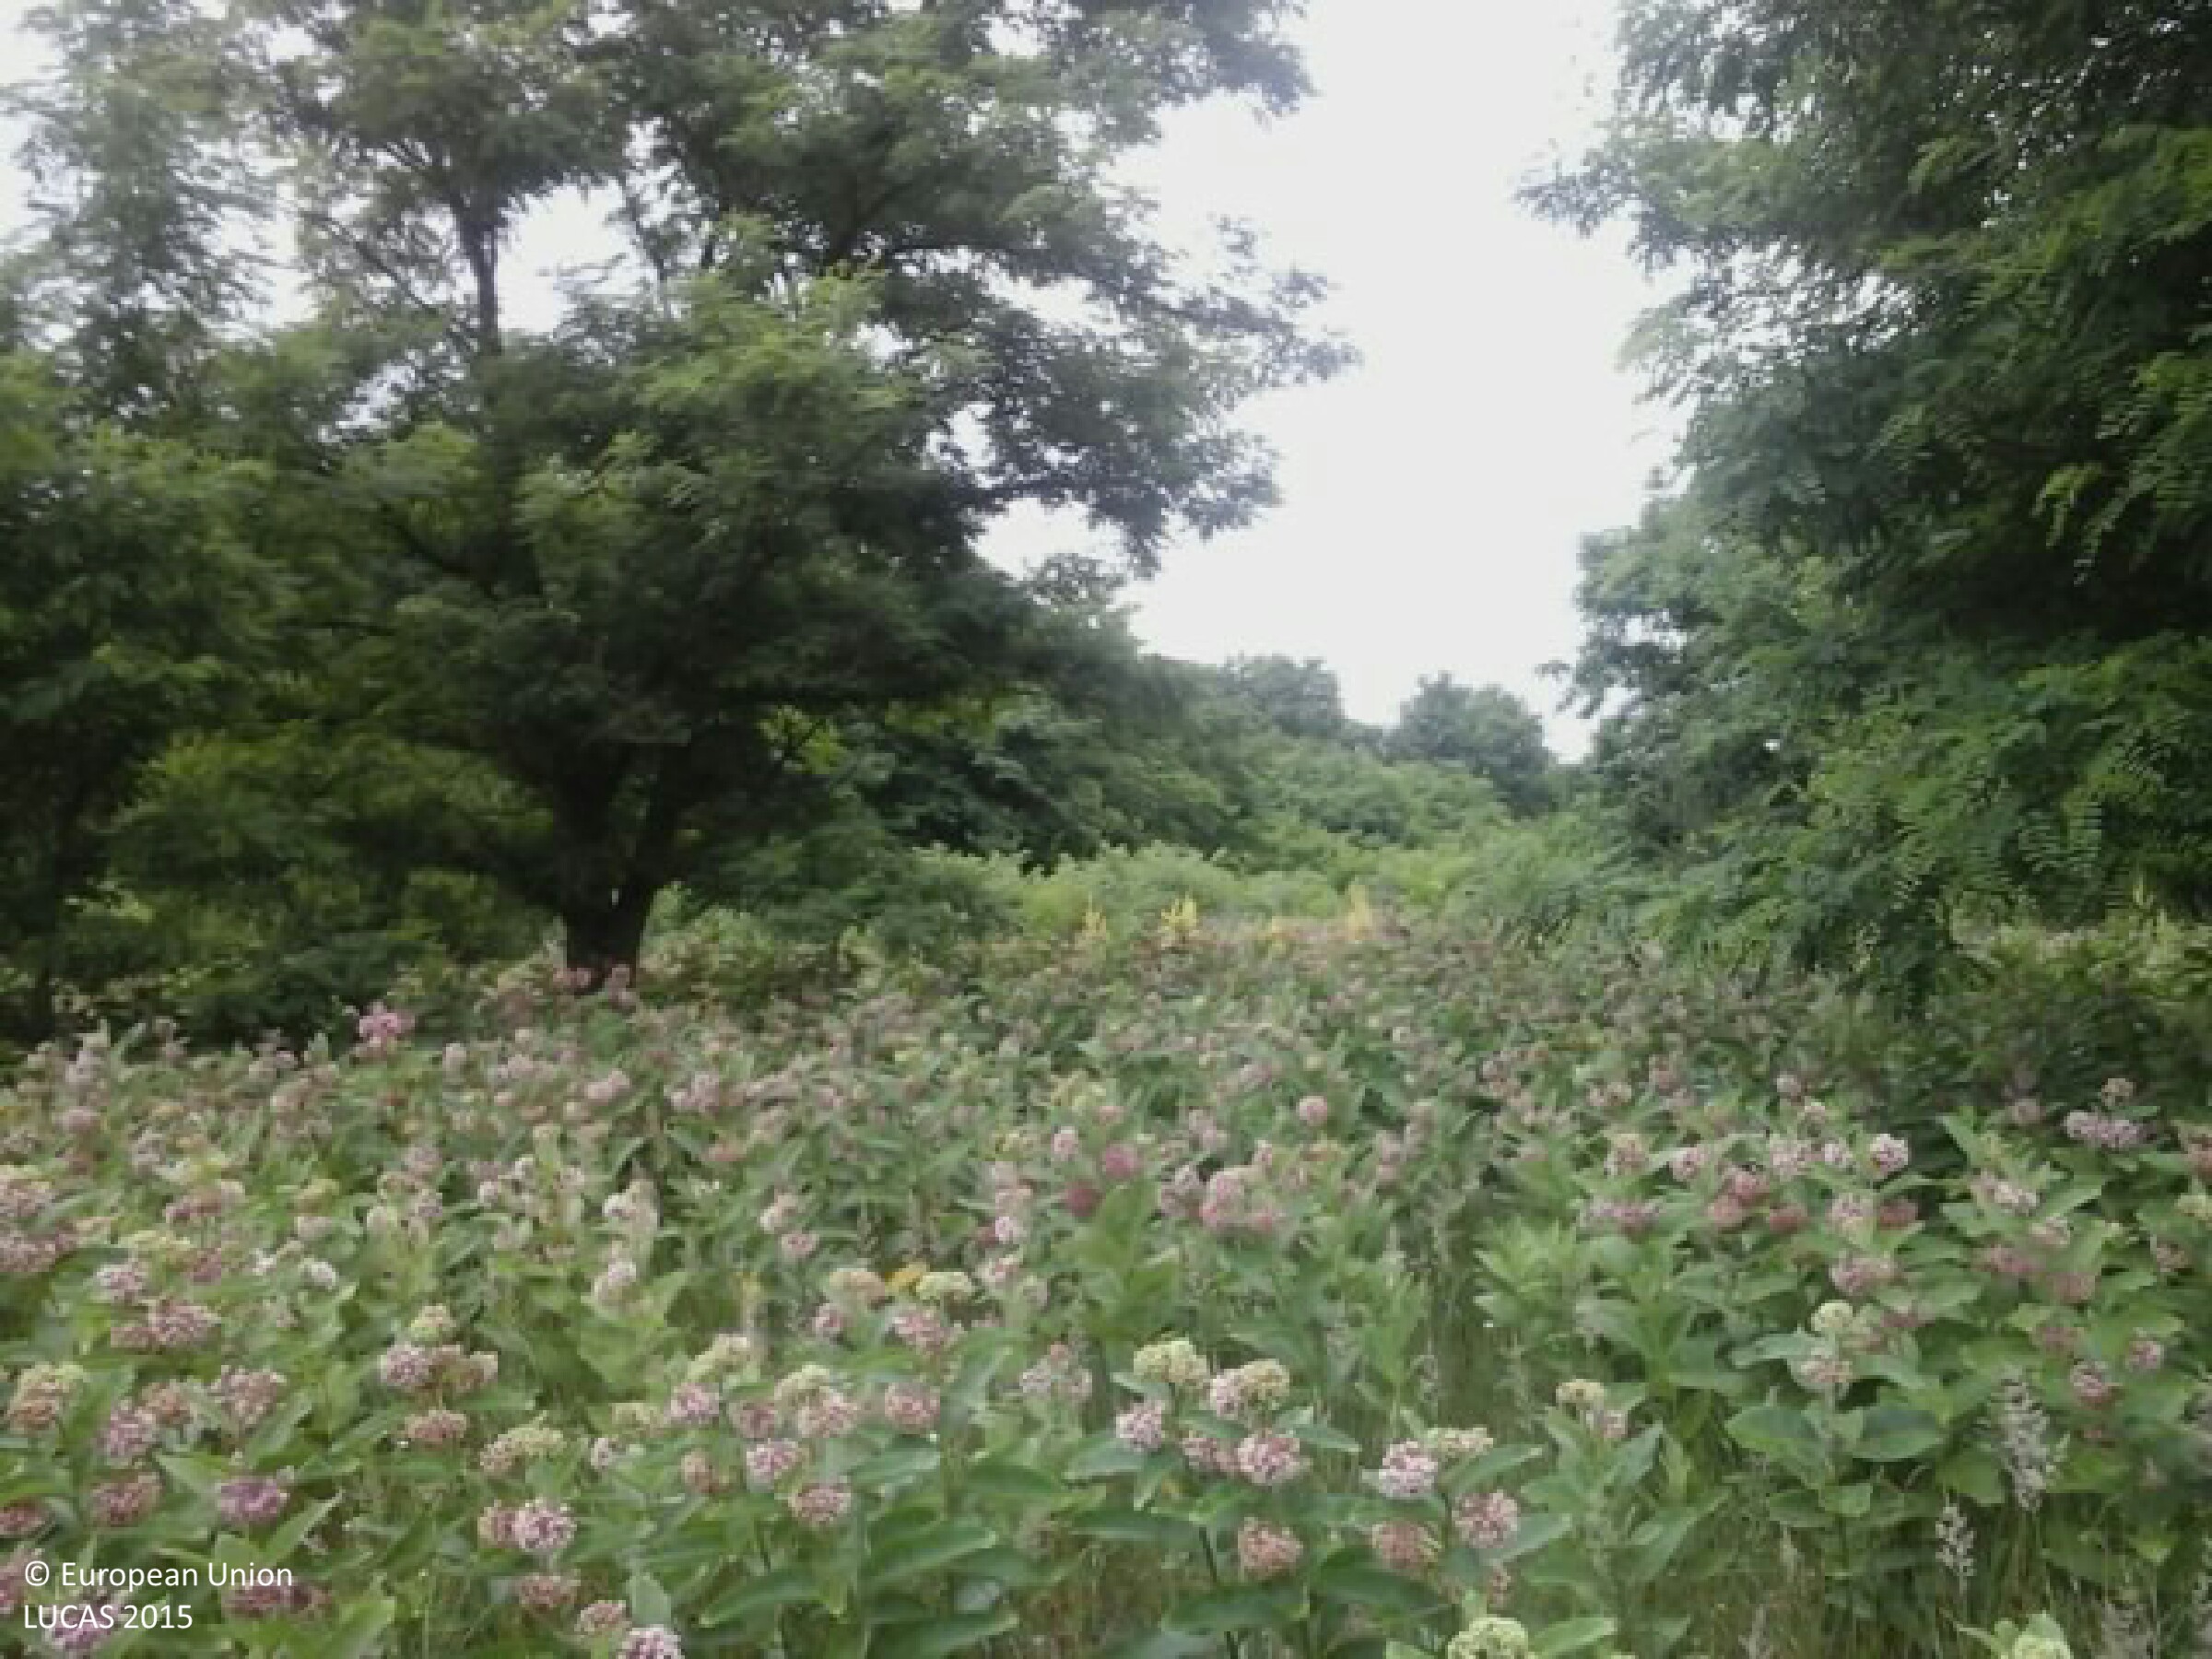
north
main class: Grassland
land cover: Grassland with sparse tree/shrub cover
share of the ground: > 75 %
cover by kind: herbaceous plants 95 %, broadleaved forest trees 5 %
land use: Agriculture (excluding fallow land and kitchen gardens)
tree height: > 5 m
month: June
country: HU
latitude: 46.7620
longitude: 19.6960
